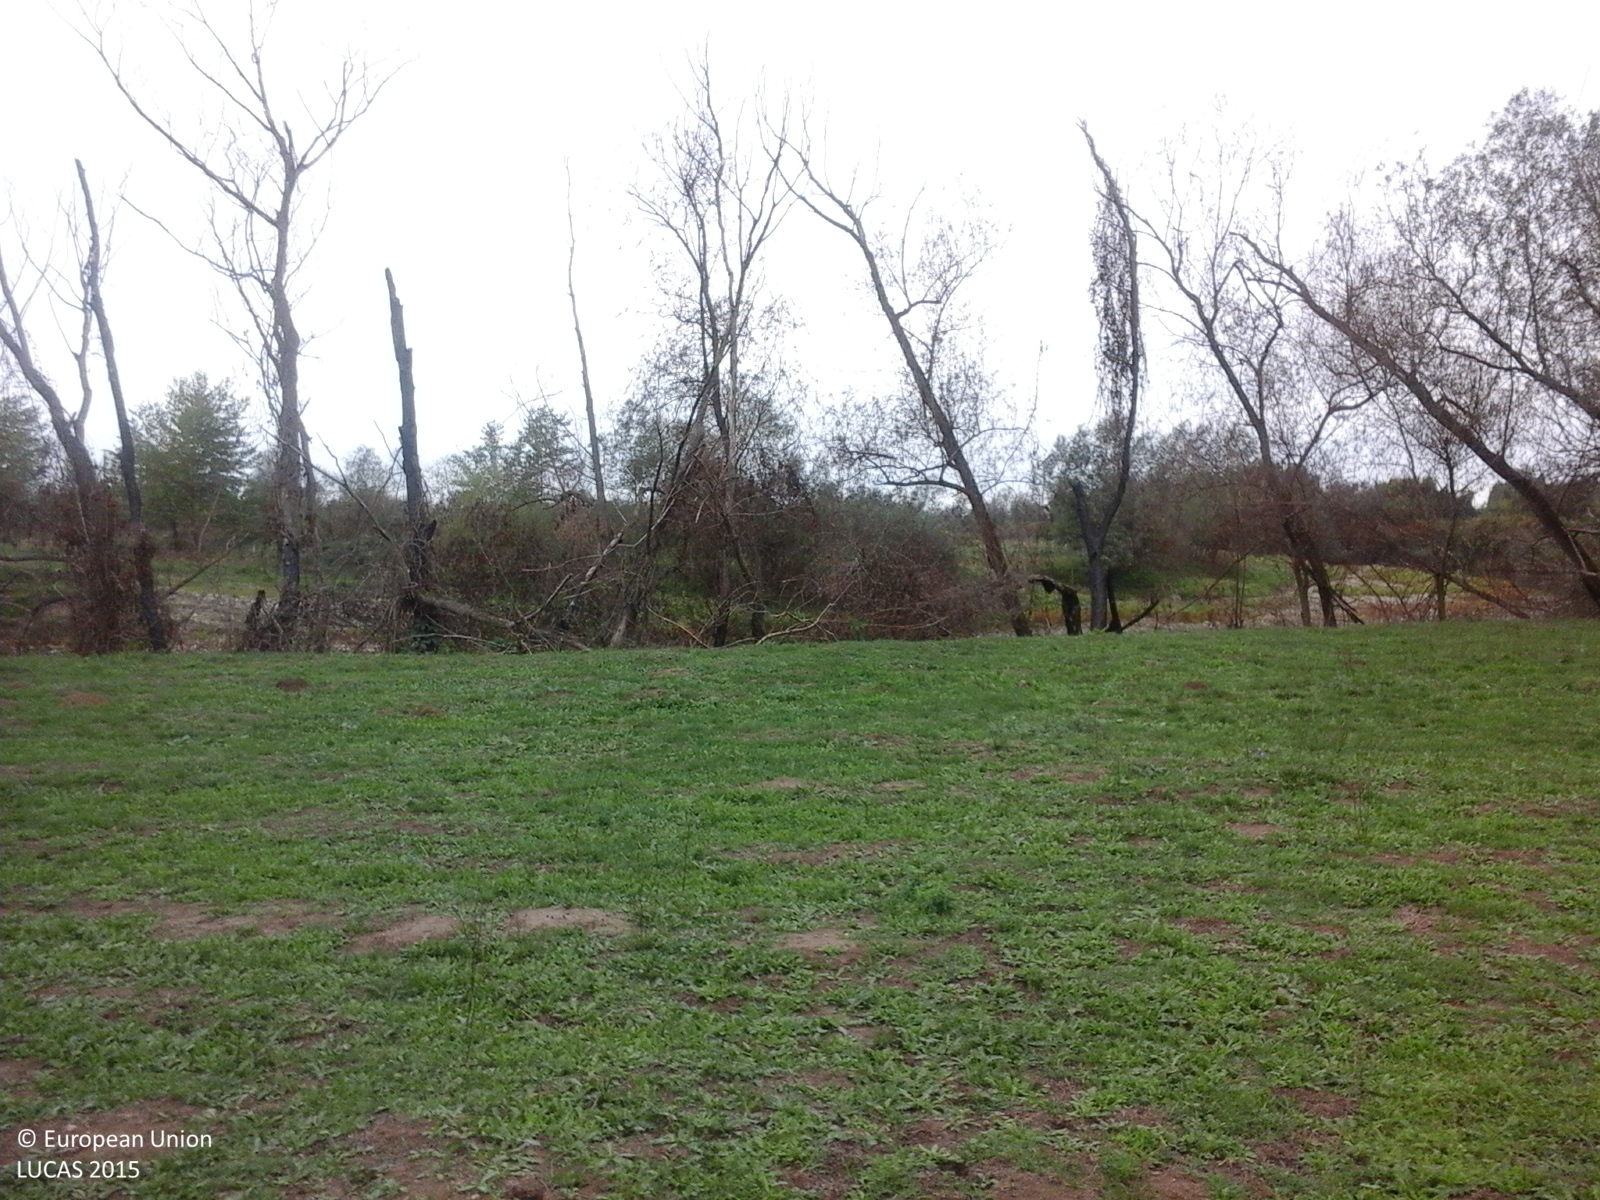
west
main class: Grassland
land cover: Grassland without tree/shrub cover
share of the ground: > 75 %
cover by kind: herbaceous plants 100 %
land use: Agriculture (excluding fallow land and kitchen gardens)
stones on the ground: < 10 %
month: September
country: RO
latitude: 45.6326
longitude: 22.0338
